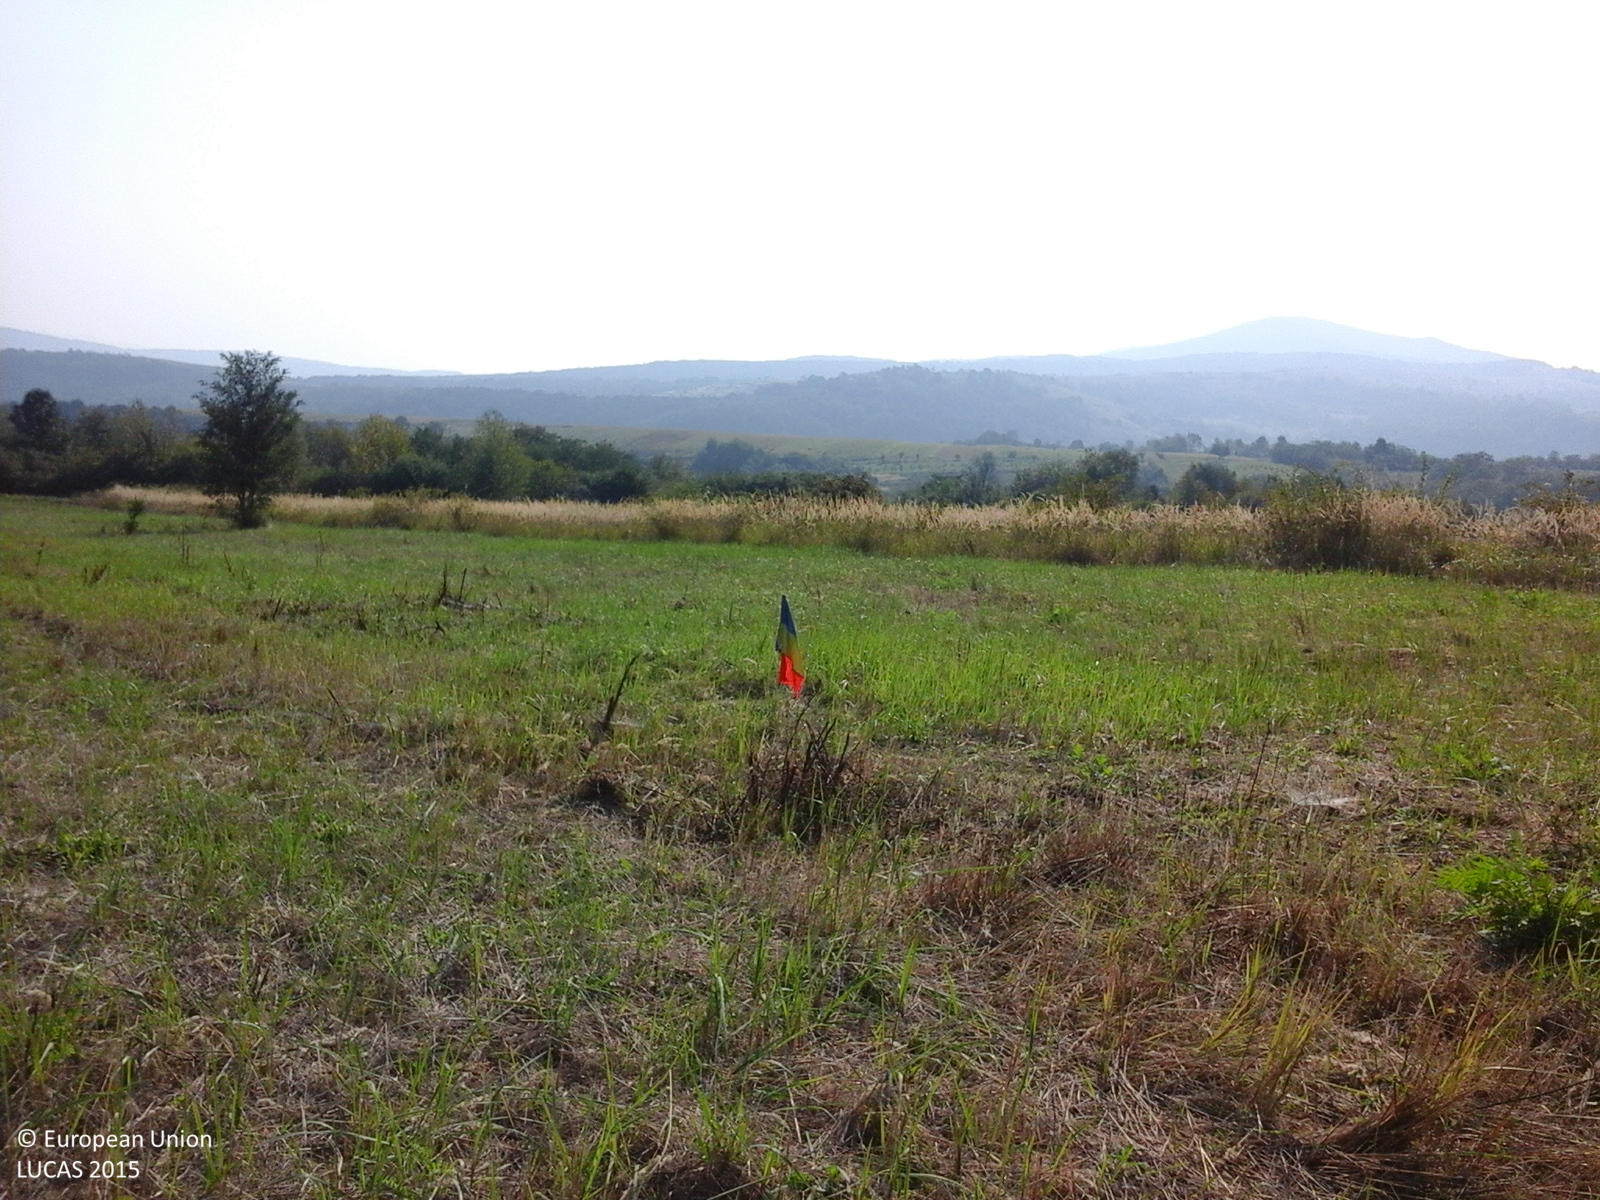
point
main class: Grassland
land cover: Grassland without tree/shrub cover
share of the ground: > 75 %
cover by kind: herbaceous plants 100 %
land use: Agriculture (excluding fallow land and kitchen gardens)
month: August
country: RO
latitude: 46.3009
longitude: 22.0795
